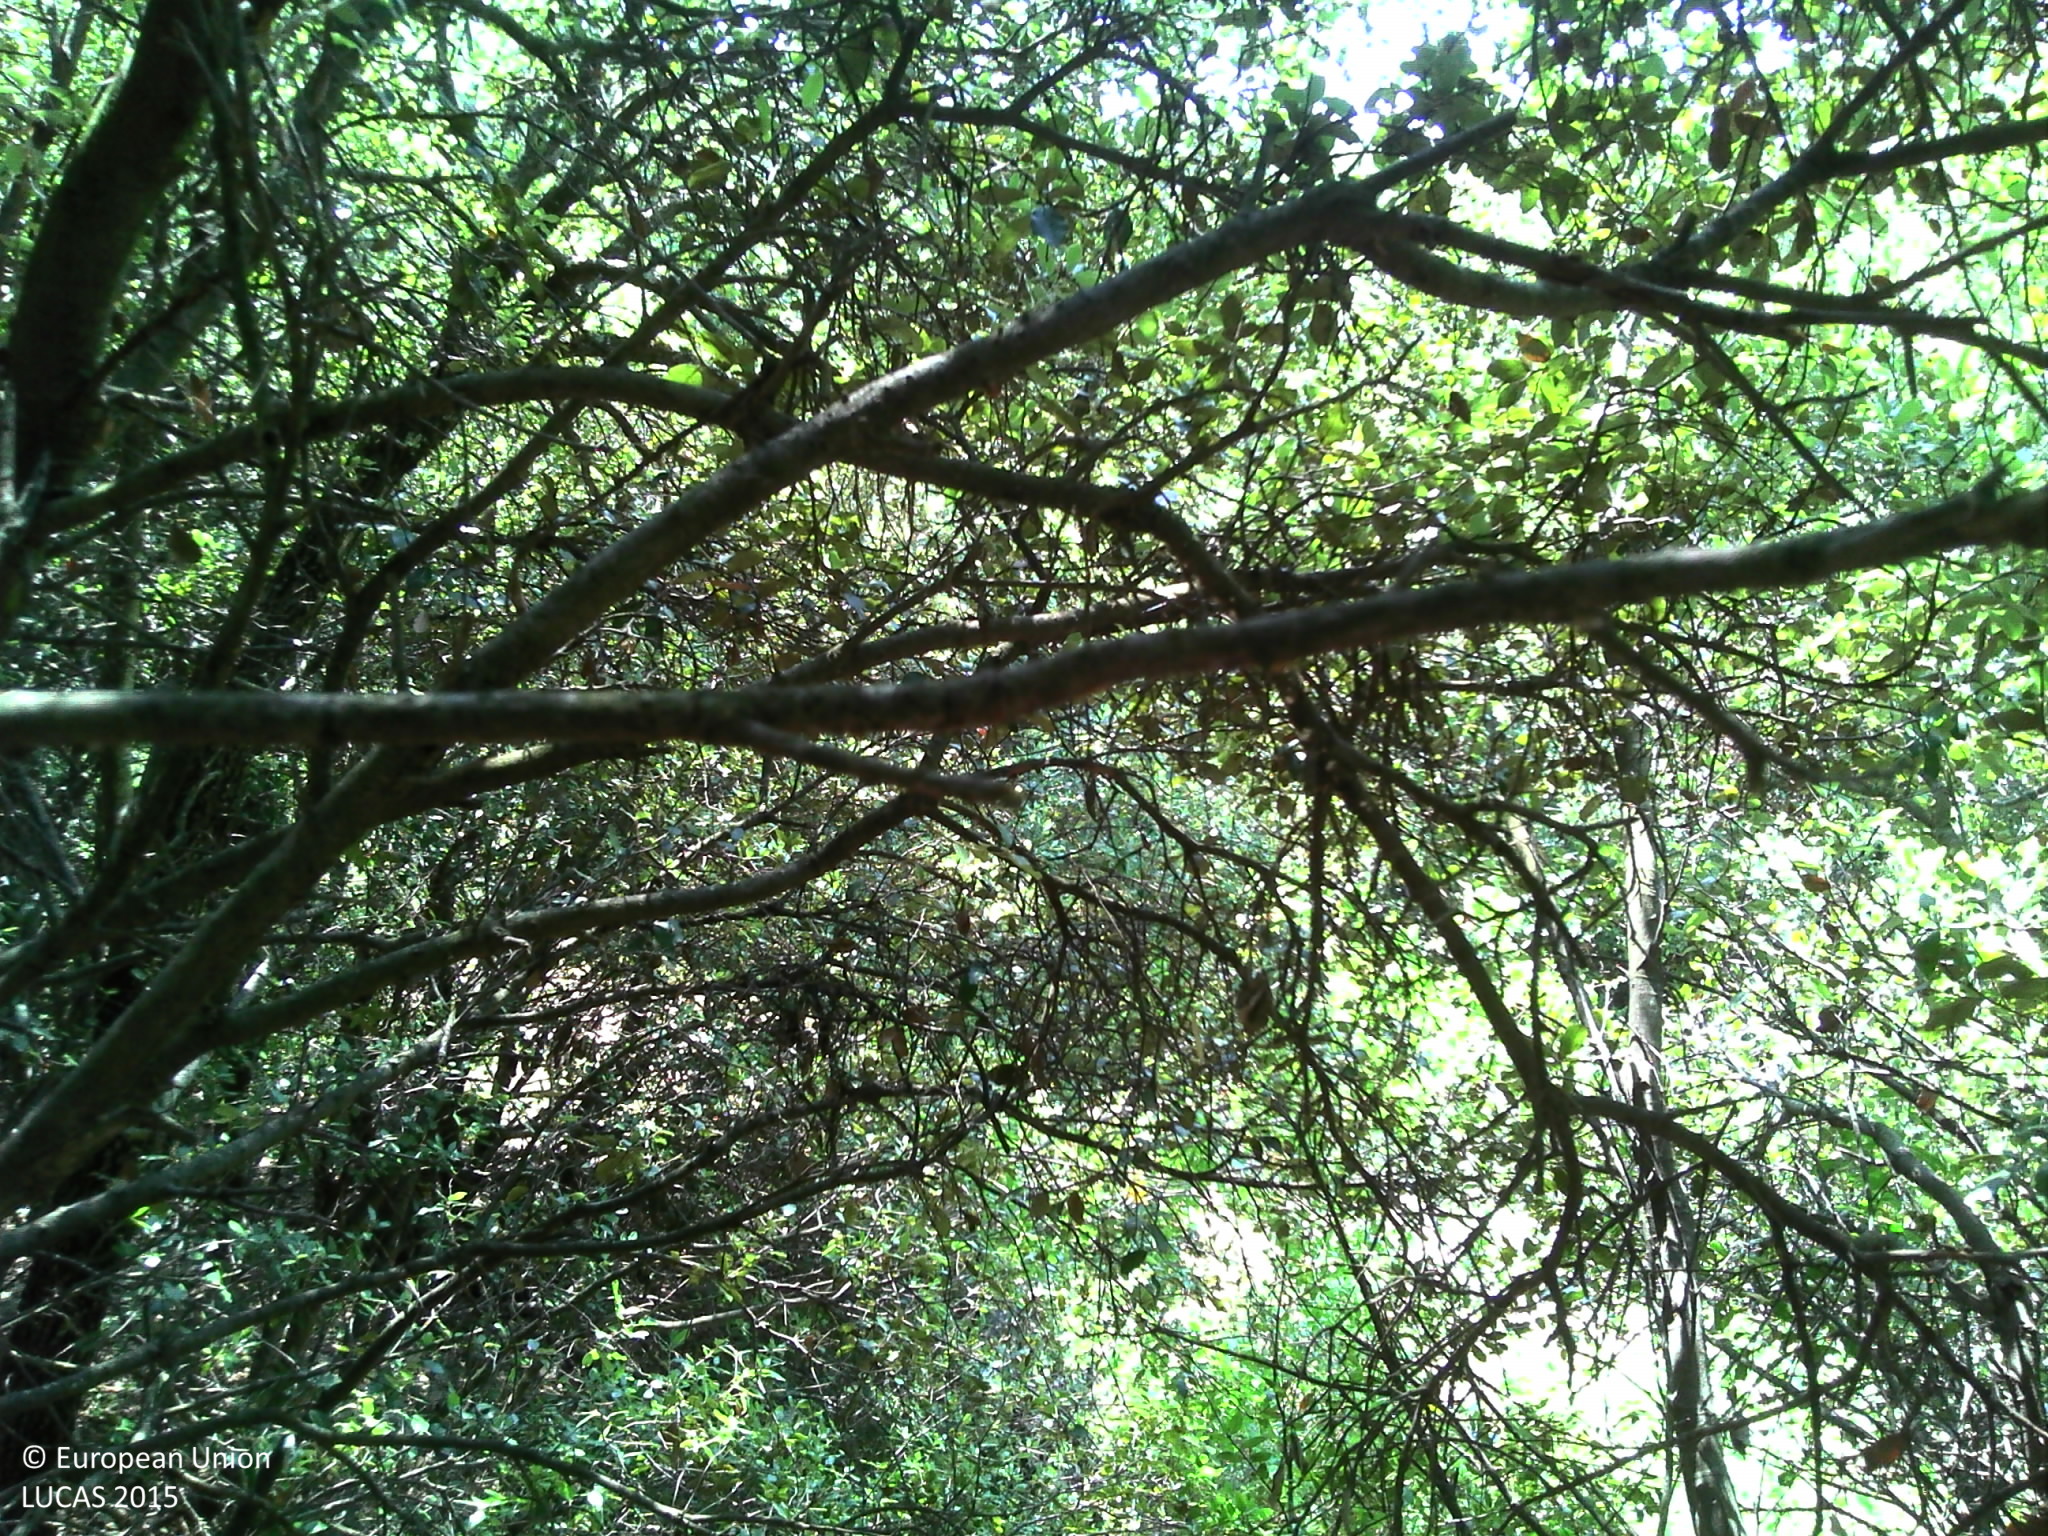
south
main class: Woodland
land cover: Broadleaved woodland
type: broadleaved evergreen forest
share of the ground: > 75 %
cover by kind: broadleaved forest trees 70 %, shrubs 15 %, coniferous forest trees 10 %, unconsolidated bare surface 5 %
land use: Semi-natural and natural areas not in use
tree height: > 5 m
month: July
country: FR
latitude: 44.0612
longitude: 5.2519
